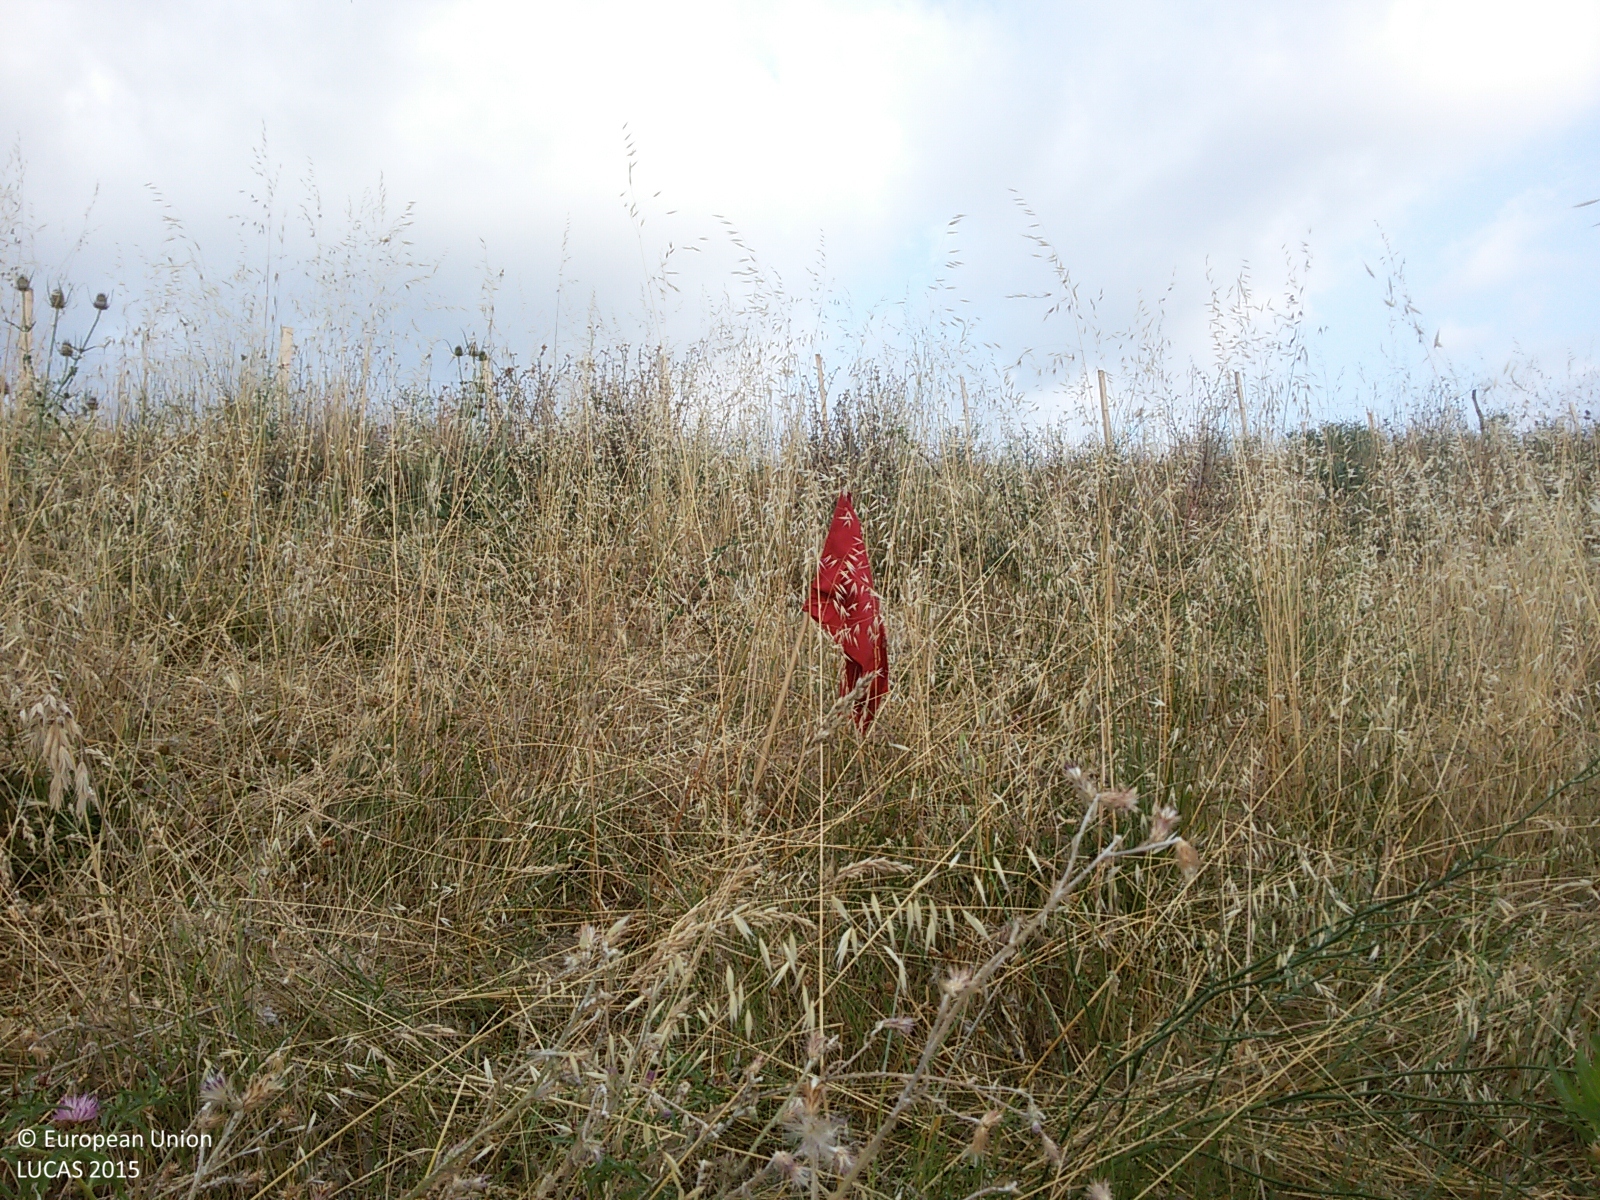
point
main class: Cropland
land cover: Temporary grasslands
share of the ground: > 75 %
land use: Agriculture (excluding fallow land and kitchen gardens)
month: July
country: IT
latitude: 42.8604
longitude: 11.4518
